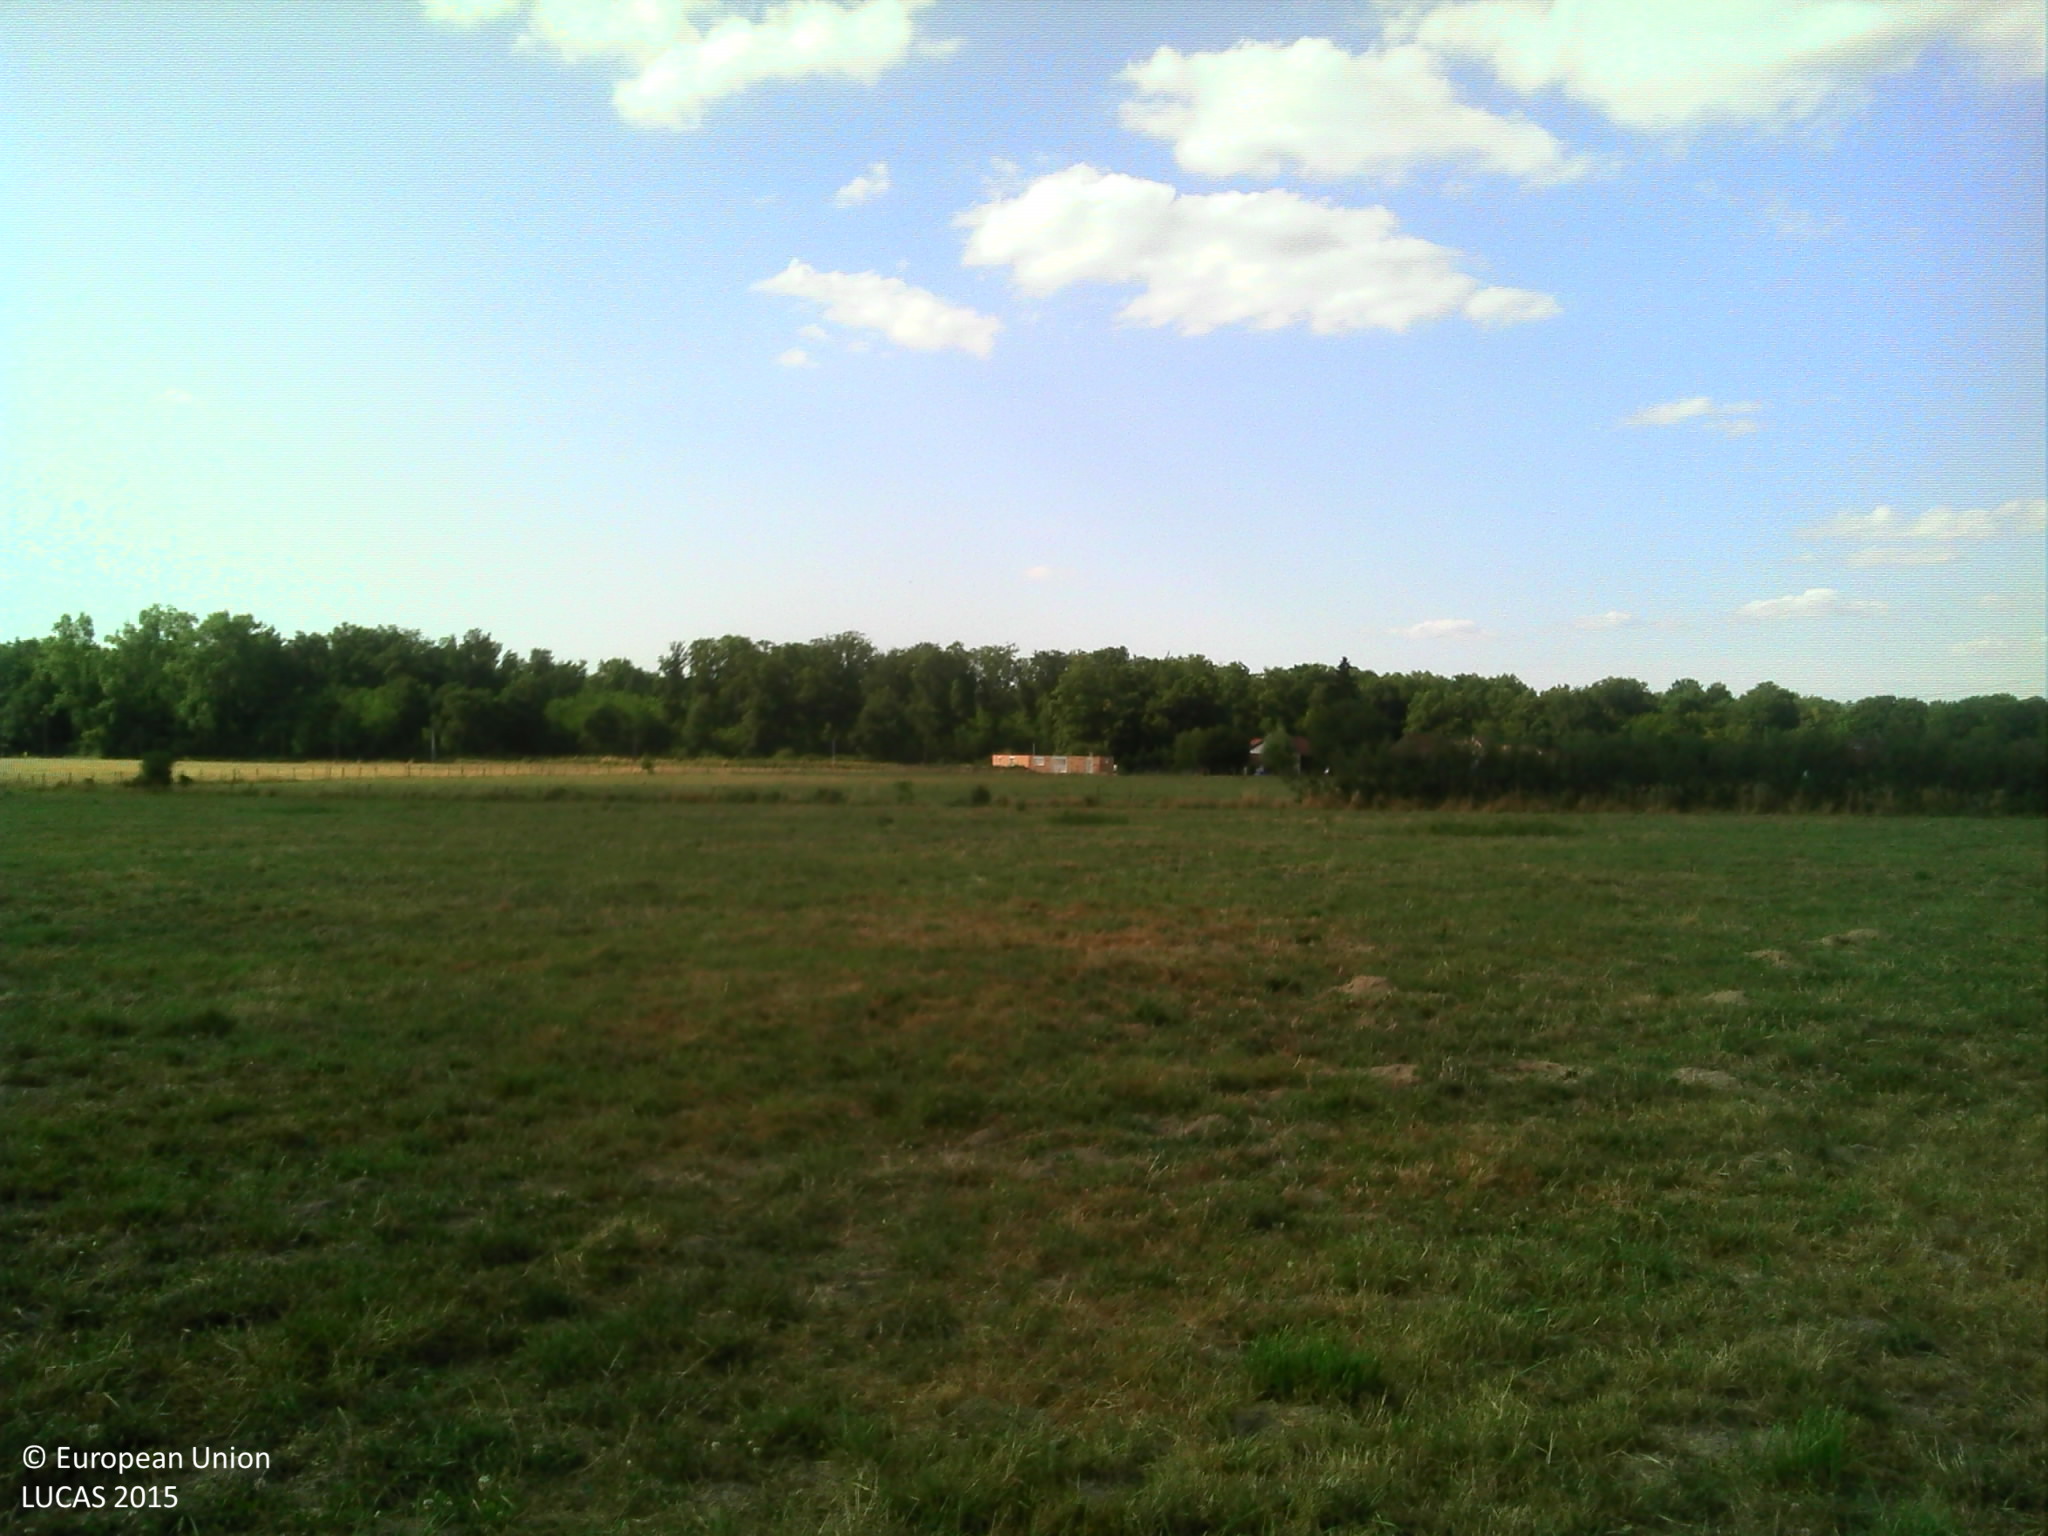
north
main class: Grassland
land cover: Grassland without tree/shrub cover
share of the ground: > 75 %
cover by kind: herbaceous plants 100 %
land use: Agriculture (excluding fallow land and kitchen gardens)
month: July
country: FR
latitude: 46.8516
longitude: 5.0834
